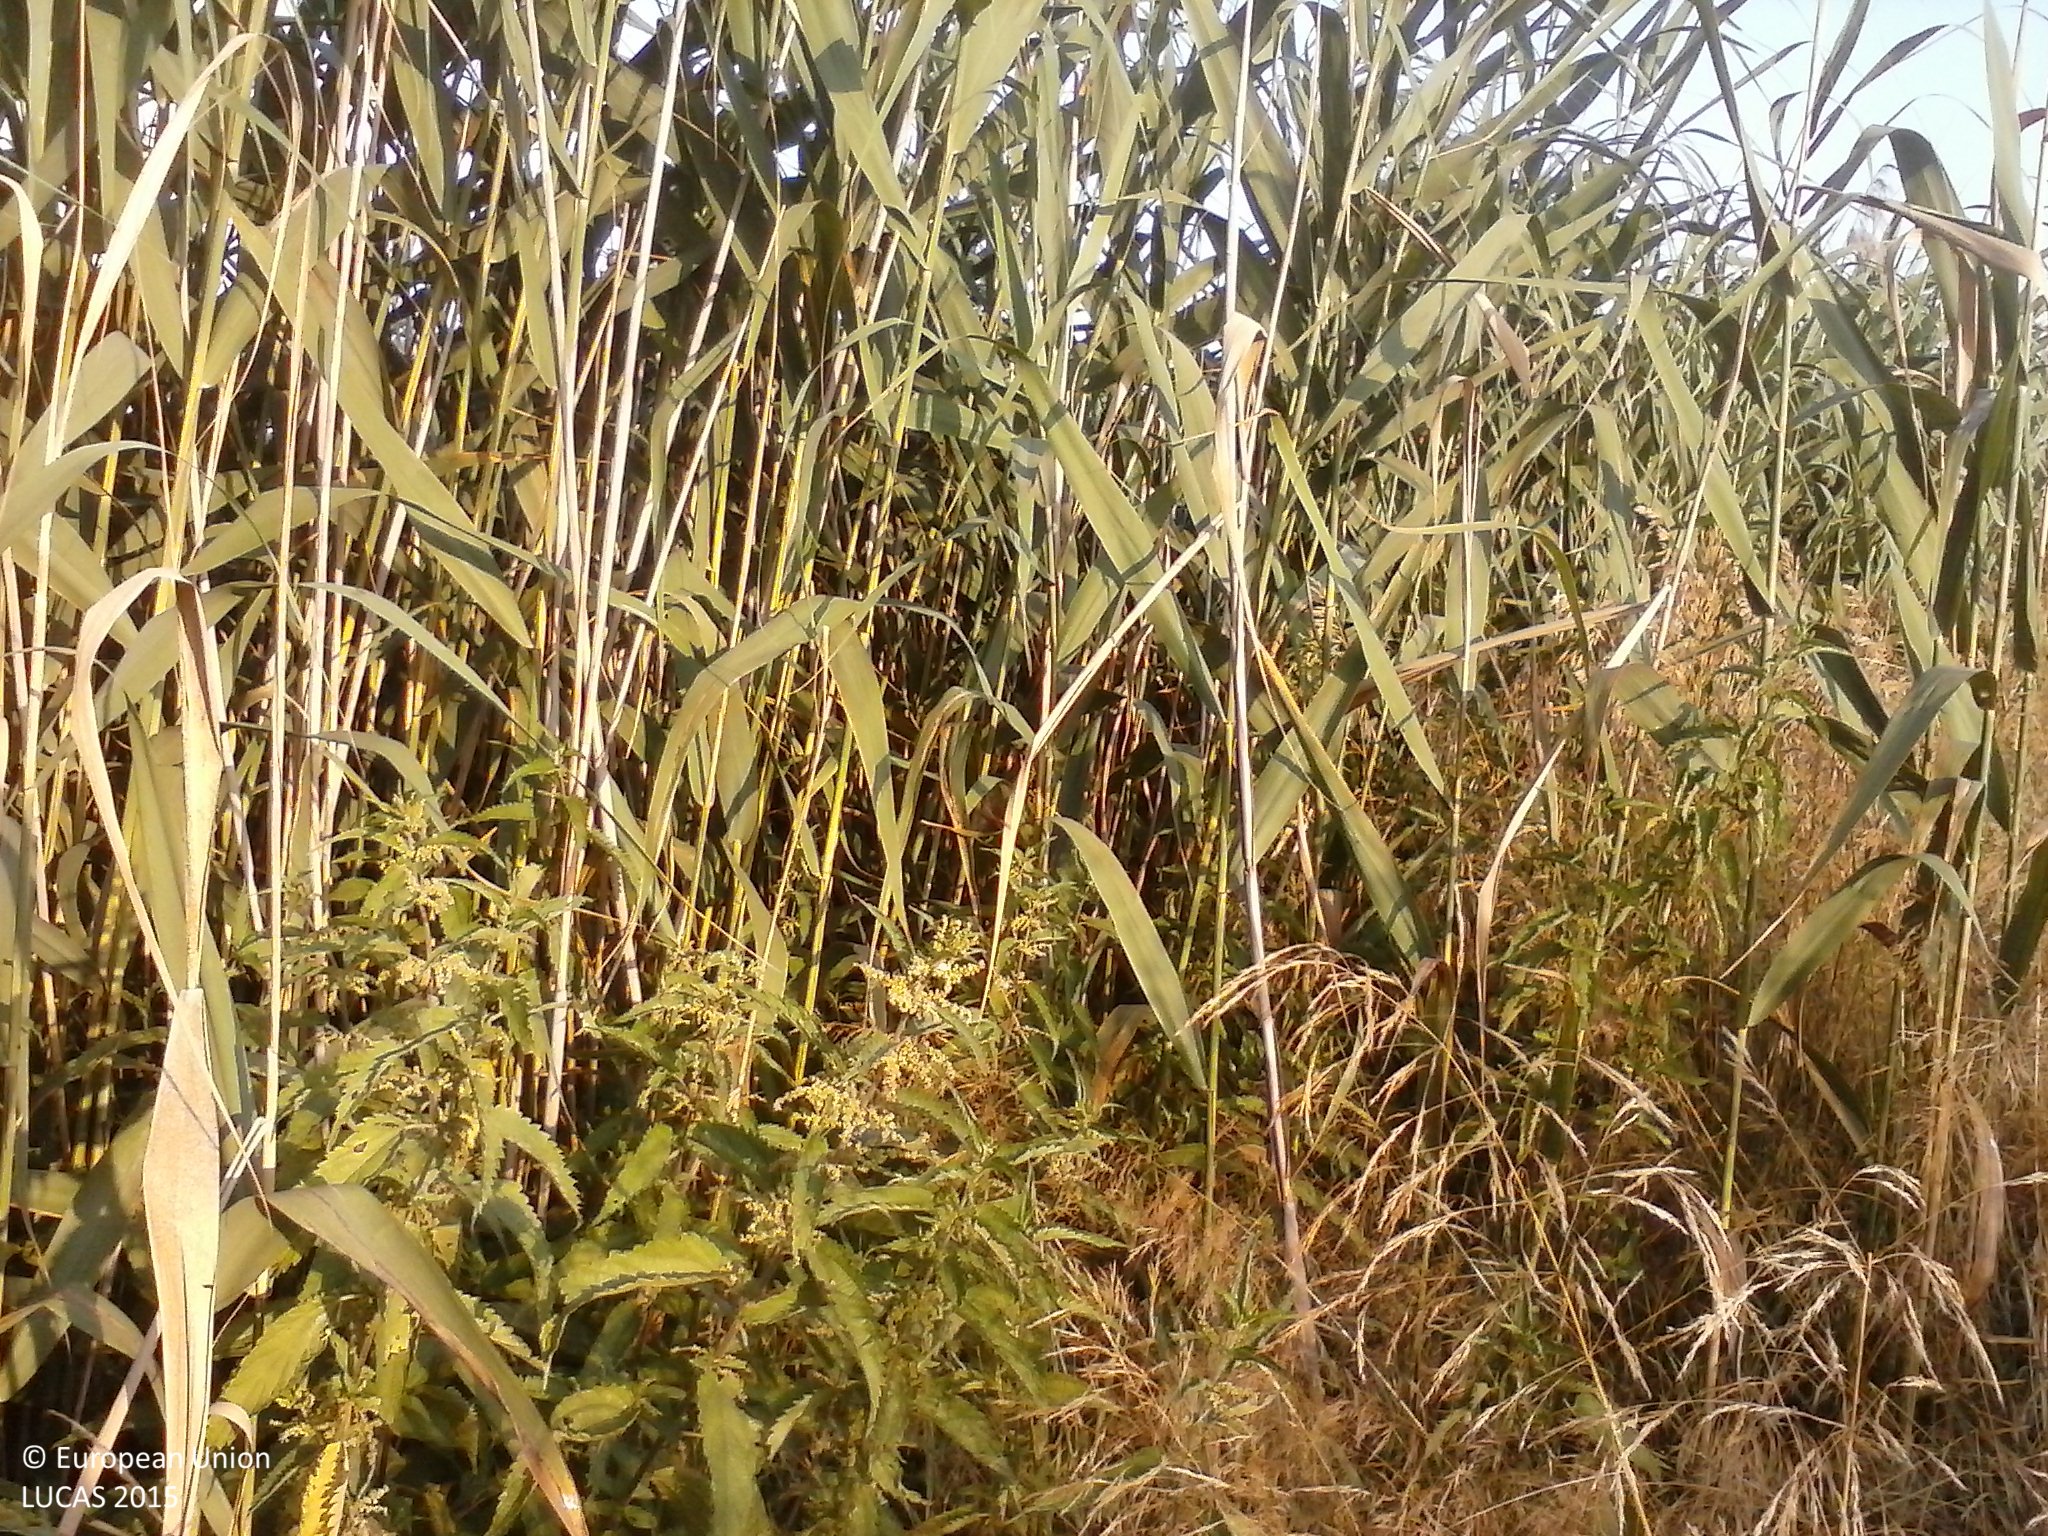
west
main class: Cropland
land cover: Rape and turnip rape
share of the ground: 10 - 25 %
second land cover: Spontaneously vegetated surfaces
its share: > 75 %
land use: Agriculture (excluding fallow land and kitchen gardens)
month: July
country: HU
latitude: 46.4324
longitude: 19.5307
